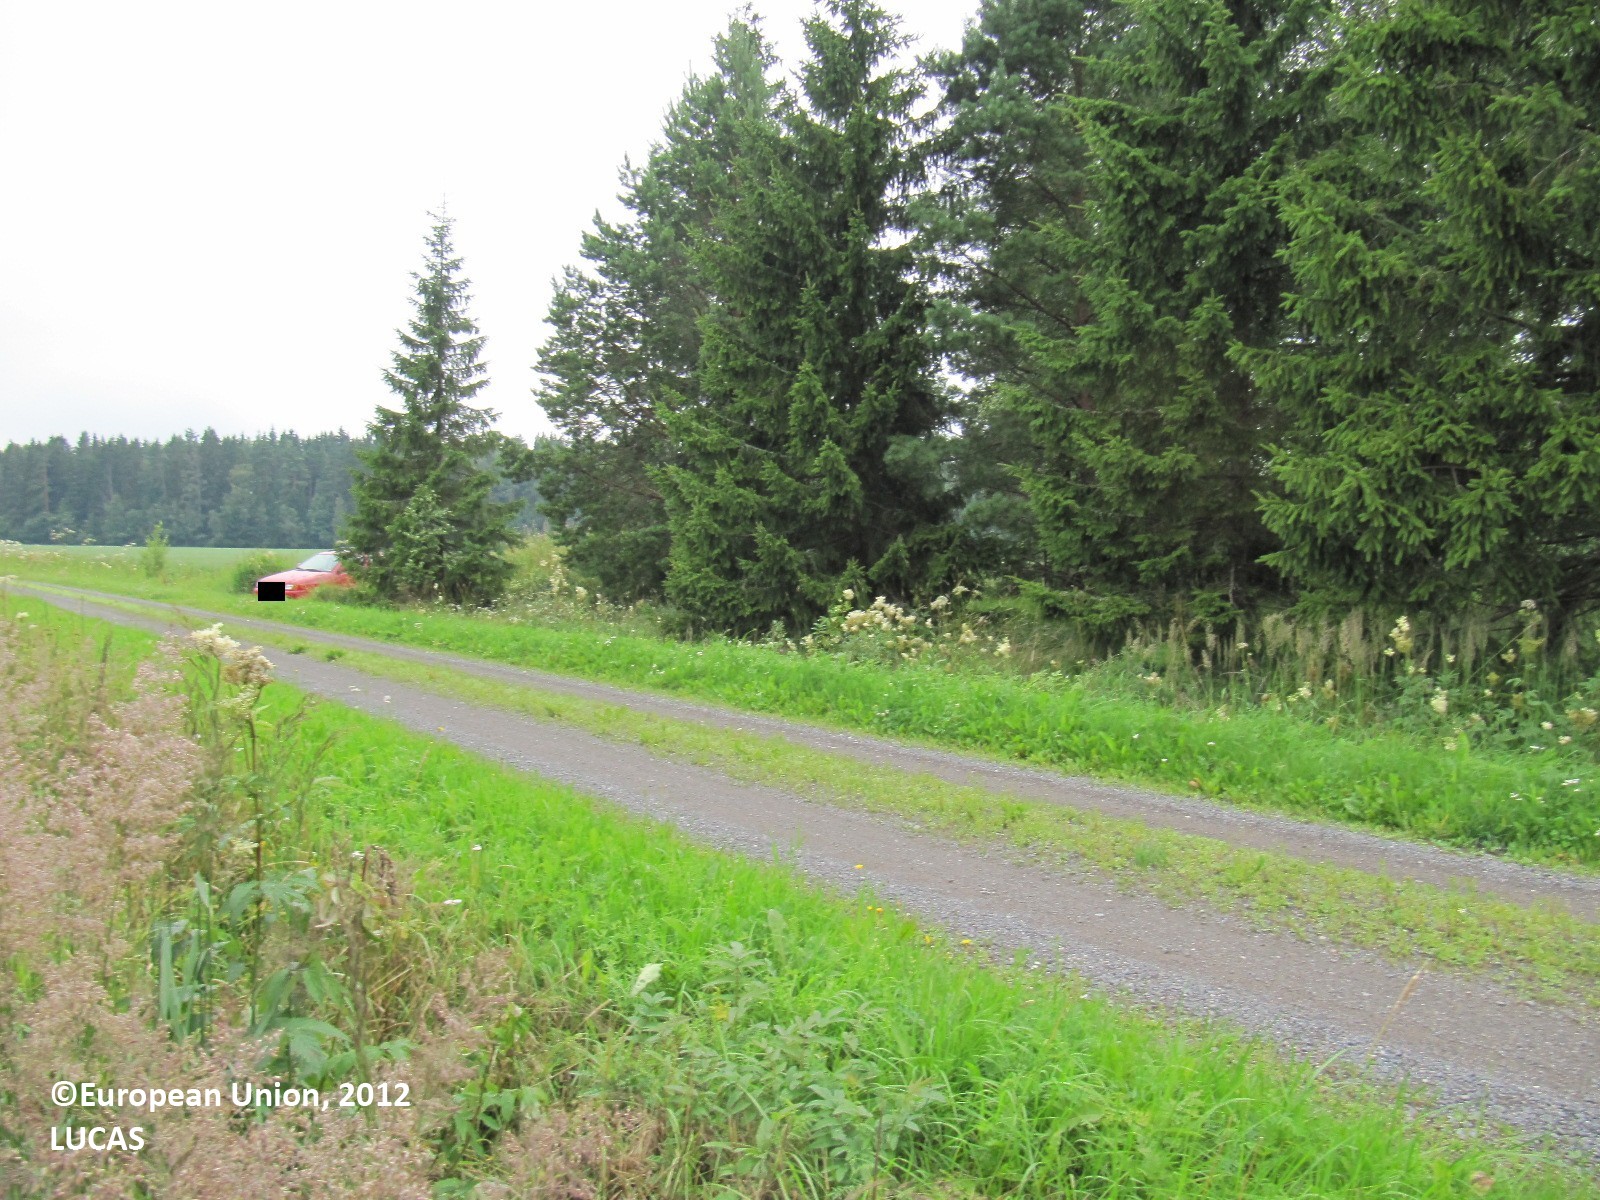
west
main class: Cropland
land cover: Common wheat
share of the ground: > 75 %
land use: Agriculture (excluding fallow land and kitchen gardens)
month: July
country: FI
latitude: 60.6976
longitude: 23.3255
